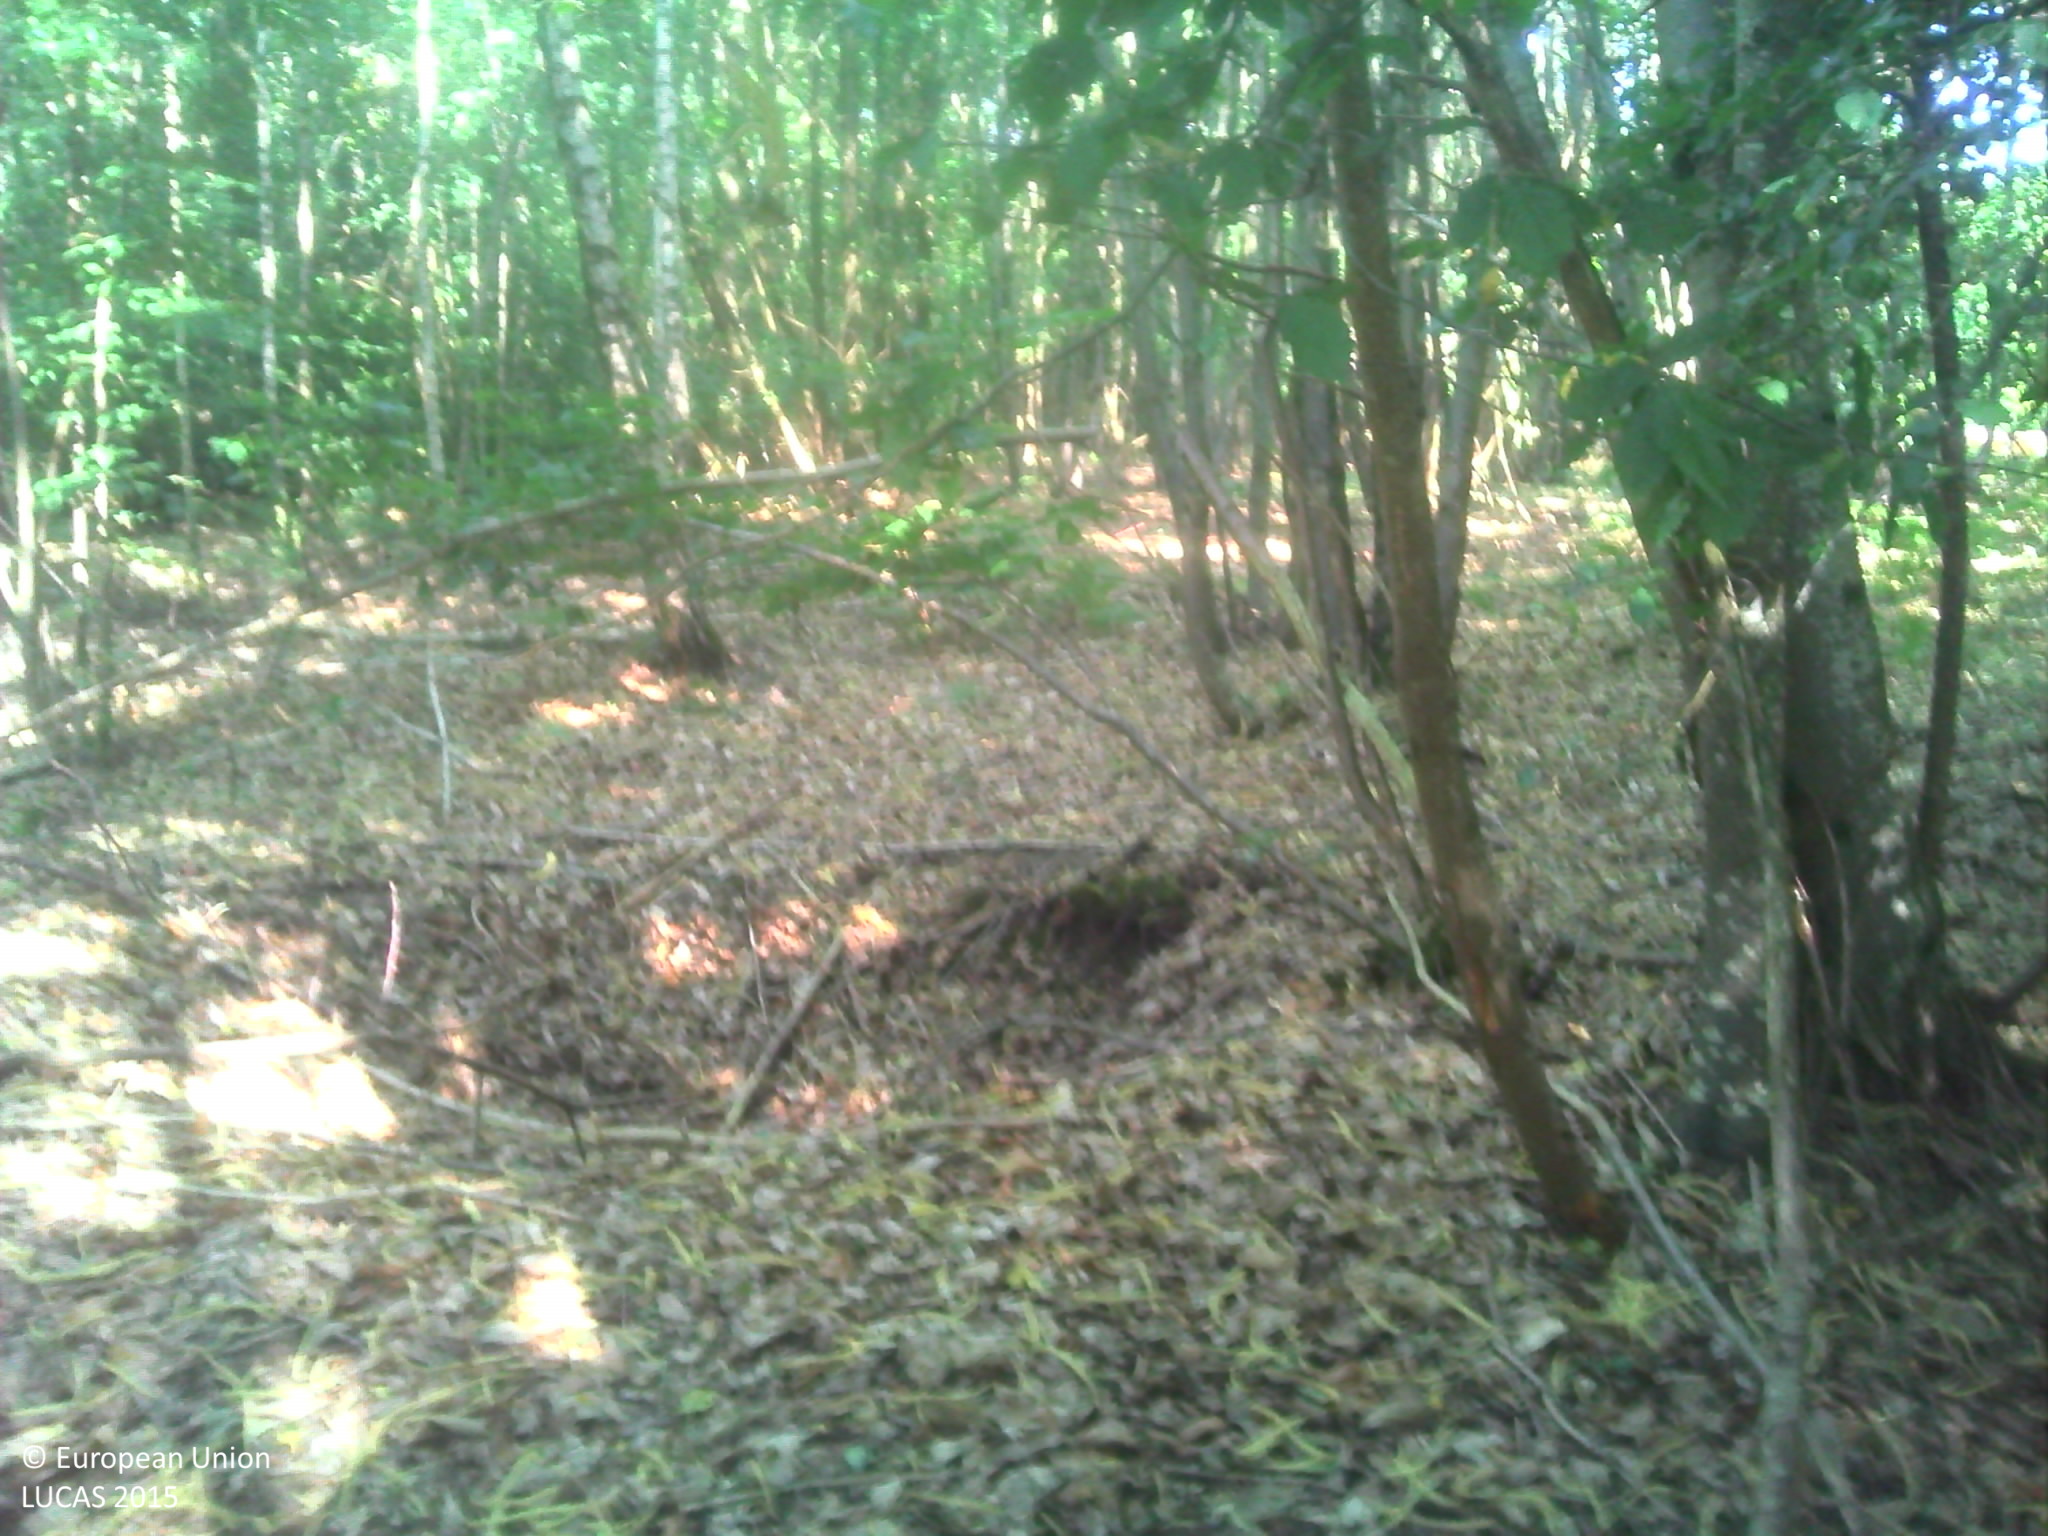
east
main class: Woodland
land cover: Broadleaved woodland
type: mesophytic deciduous forest
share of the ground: > 75 %
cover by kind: broadleaved forest trees 80 %, herbaceous plants 10 %, lichens and mosses 5 %, unconsolidated bare surface 5 %
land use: Forestry
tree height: > 5 m
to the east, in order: Broadleaved woodland; Ditches and canals; Broadleaved woodland; Ditches and canals; Paved roads, cycling and walking lanes; Ditches and canals; Broadleaved woodland; Tracks; Broadleaved woodland
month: July
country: FR
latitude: 47.7044
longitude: 0.7174
